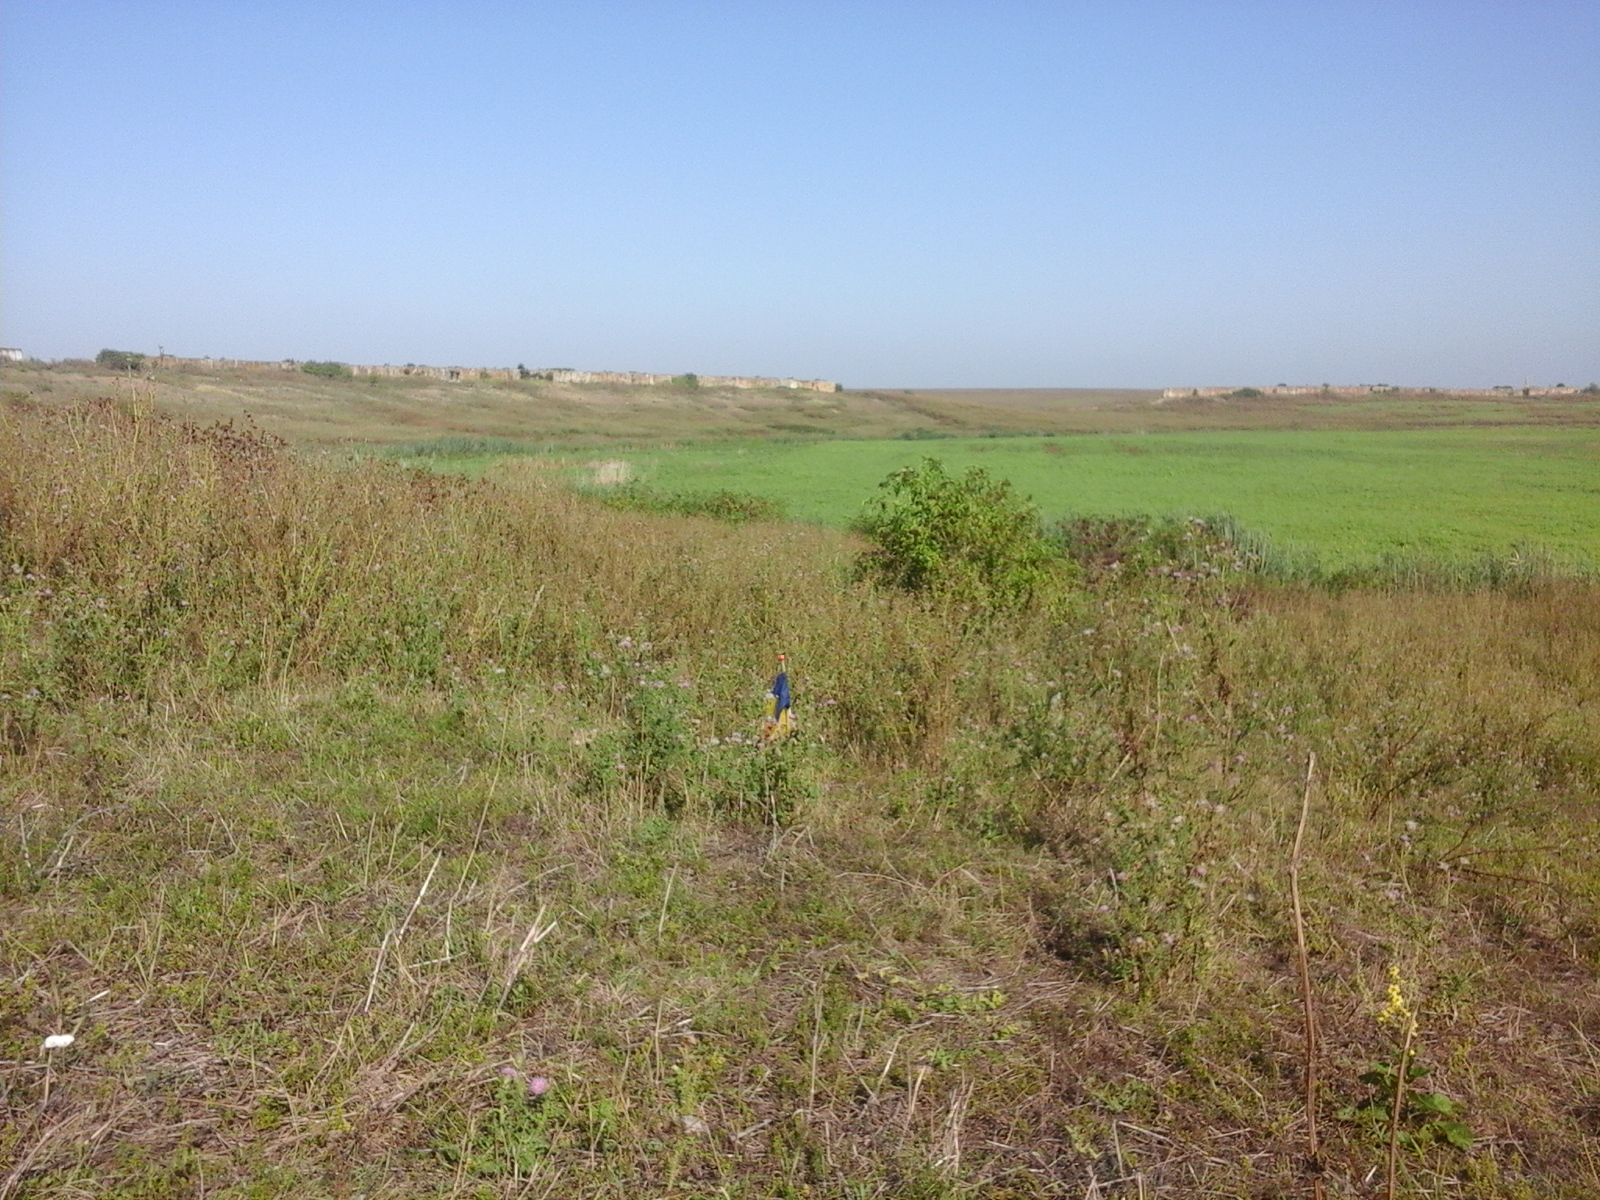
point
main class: Grassland
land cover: Spontaneously vegetated surfaces
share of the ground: > 75 %
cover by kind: herbaceous plants 100 %
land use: Fallow land
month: August
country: RO
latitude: 45.8809
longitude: 21.0978
